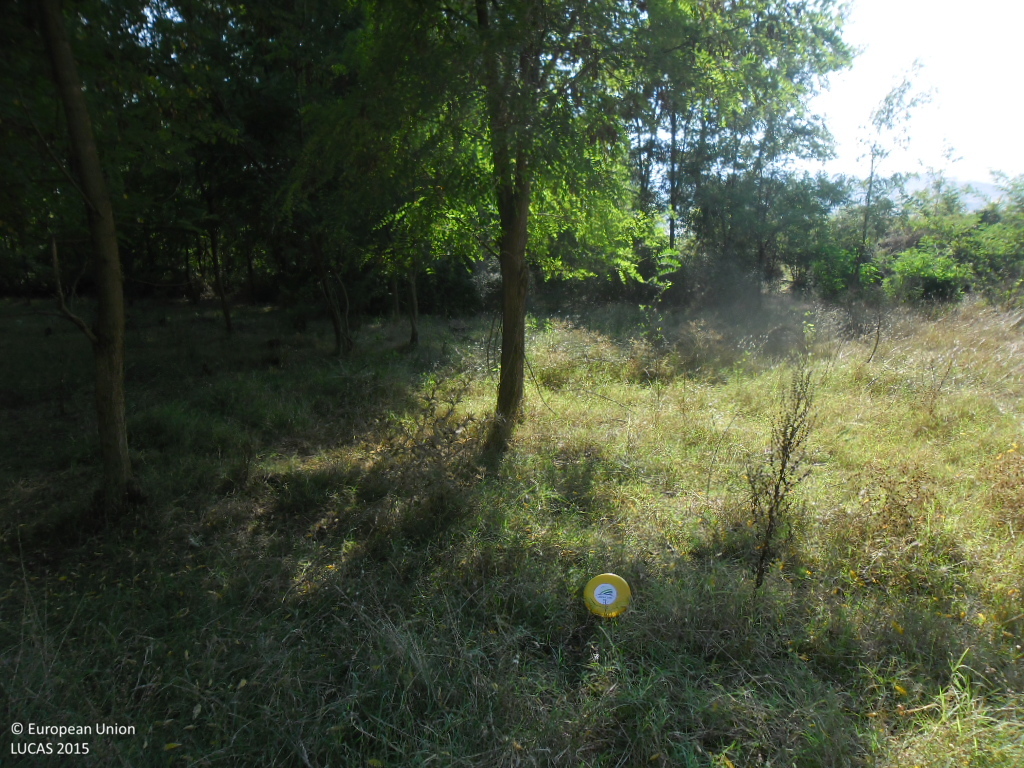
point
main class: Woodland
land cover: Broadleaved woodland
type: mesophytic deciduous forest
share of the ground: > 75 %
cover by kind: broadleaved forest trees 95 %, shrubs 5 %
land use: Forestry
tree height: < 5 m
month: September
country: BG
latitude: 41.6199
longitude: 23.2113
